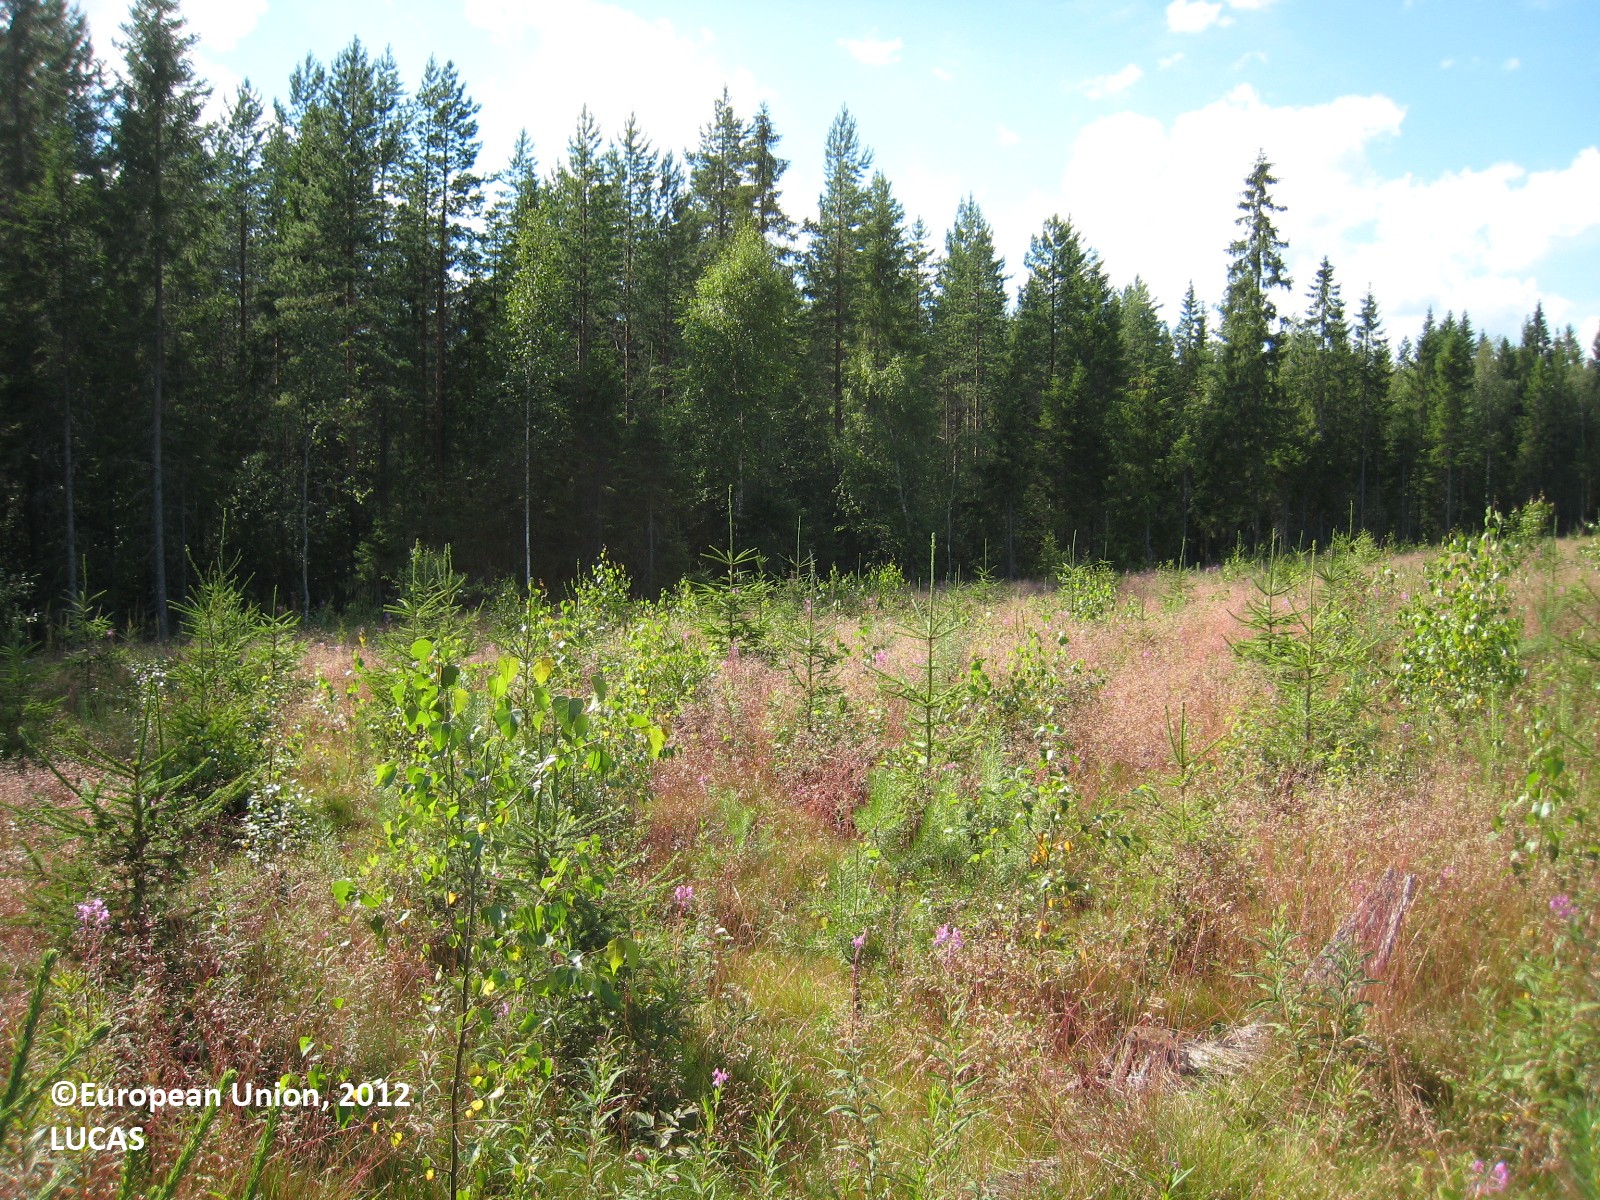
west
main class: Woodland
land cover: Other mixed woodland
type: boreal forest
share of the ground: 25 - 50 %
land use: Forestry
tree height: < 5 m
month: July
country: FI
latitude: 62.6937
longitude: 27.2947
